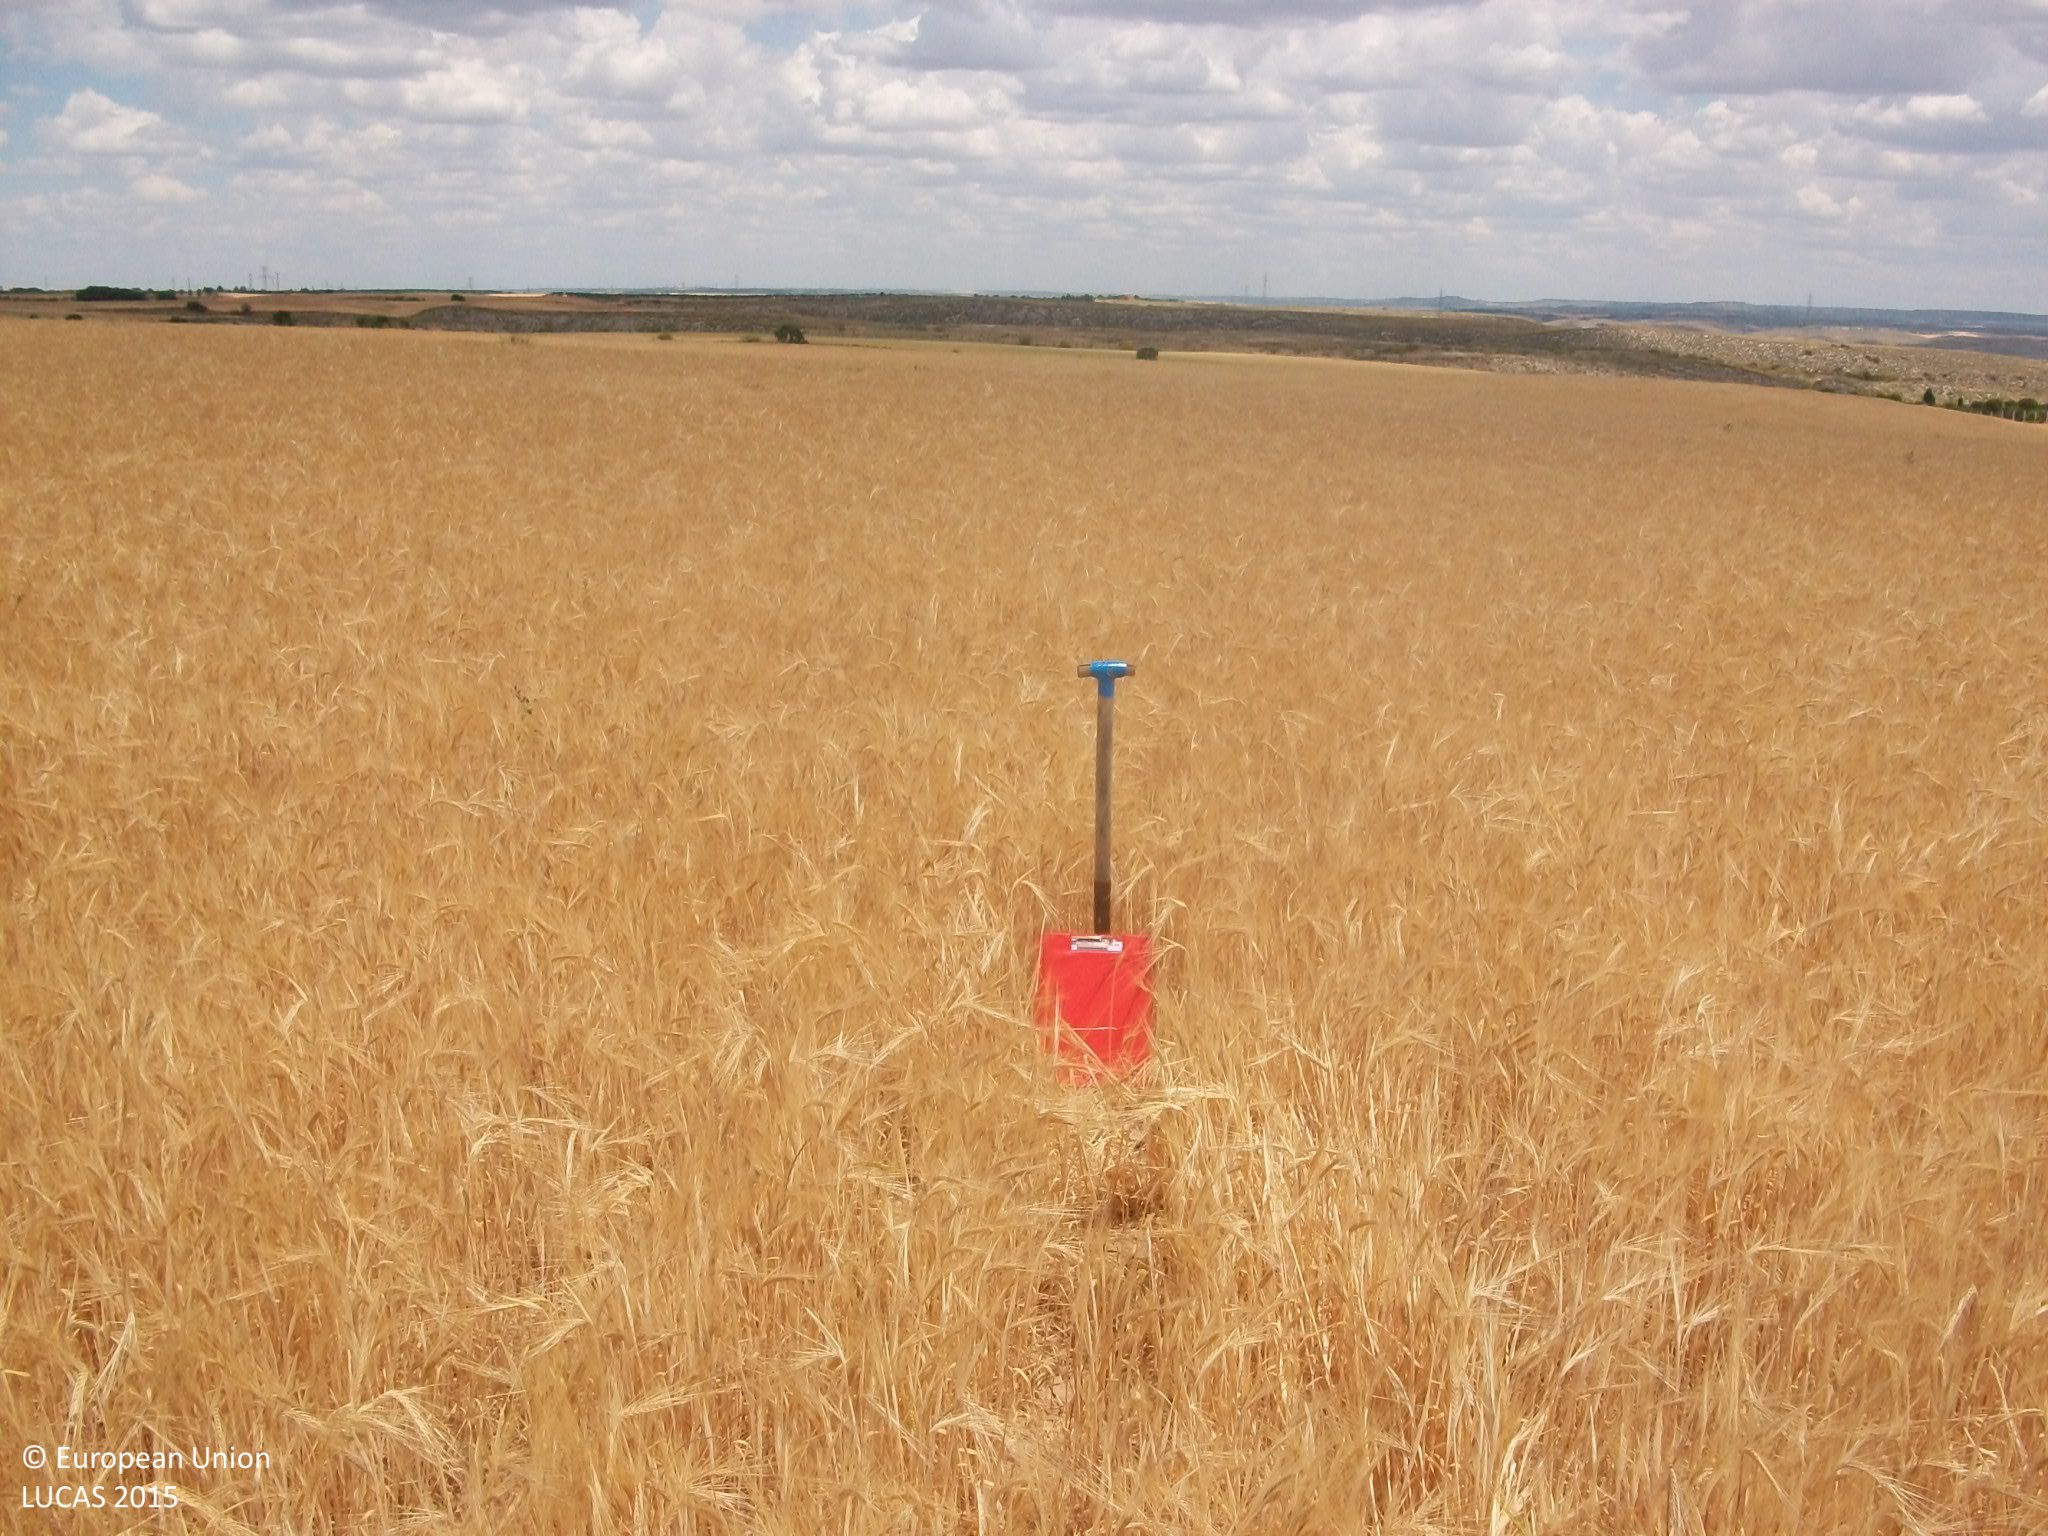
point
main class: Cropland
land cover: Barley
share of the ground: > 75 %
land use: Agriculture (excluding fallow land and kitchen gardens)
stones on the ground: 10 - 25 %
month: May
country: ES
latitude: 40.0750
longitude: -3.6701
